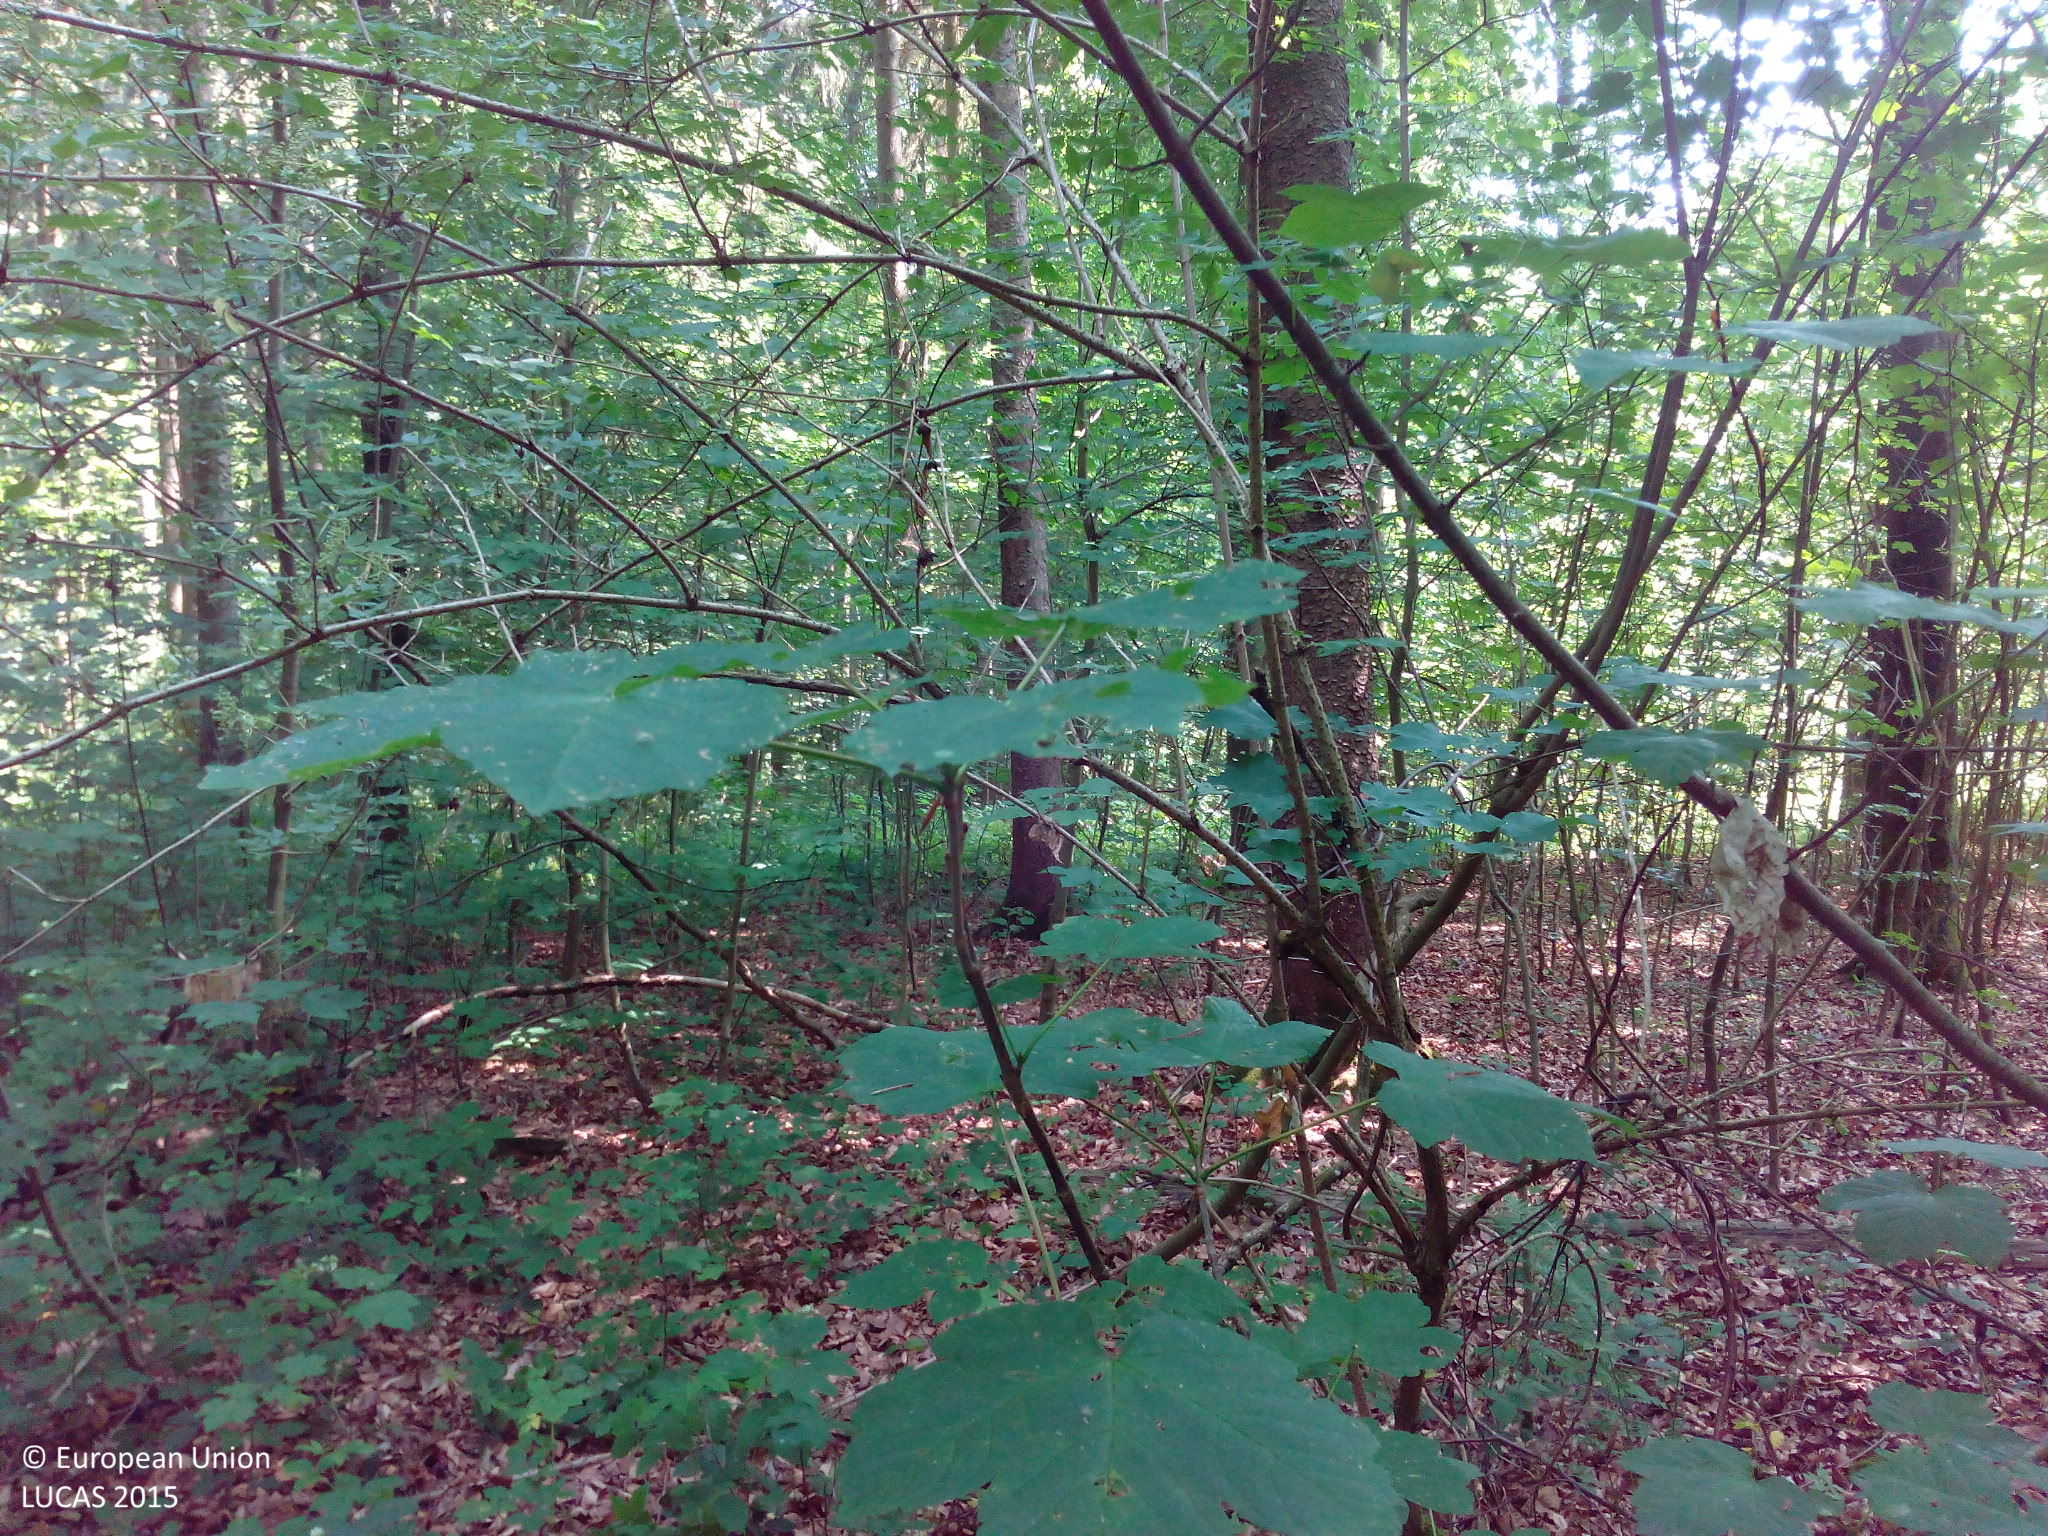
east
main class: Woodland
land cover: Pine dominated mixed woodland
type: hemiboreal forest and nemoral coniferous forest and mixed broadleaved-coniferous forest
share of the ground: > 75 %
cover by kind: broadleaved forest trees 65 %, coniferous forest trees 25 %, shrubs 5 %, herbaceous plants 5 %
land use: Forestry
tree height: > 5 m
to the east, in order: Pine dominated mixed woodland; Tracks; Spruce dominated mixed woodland; Tracks; Spruce dominated coniferous woodland
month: July
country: DE
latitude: 49.5547
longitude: 9.9033
